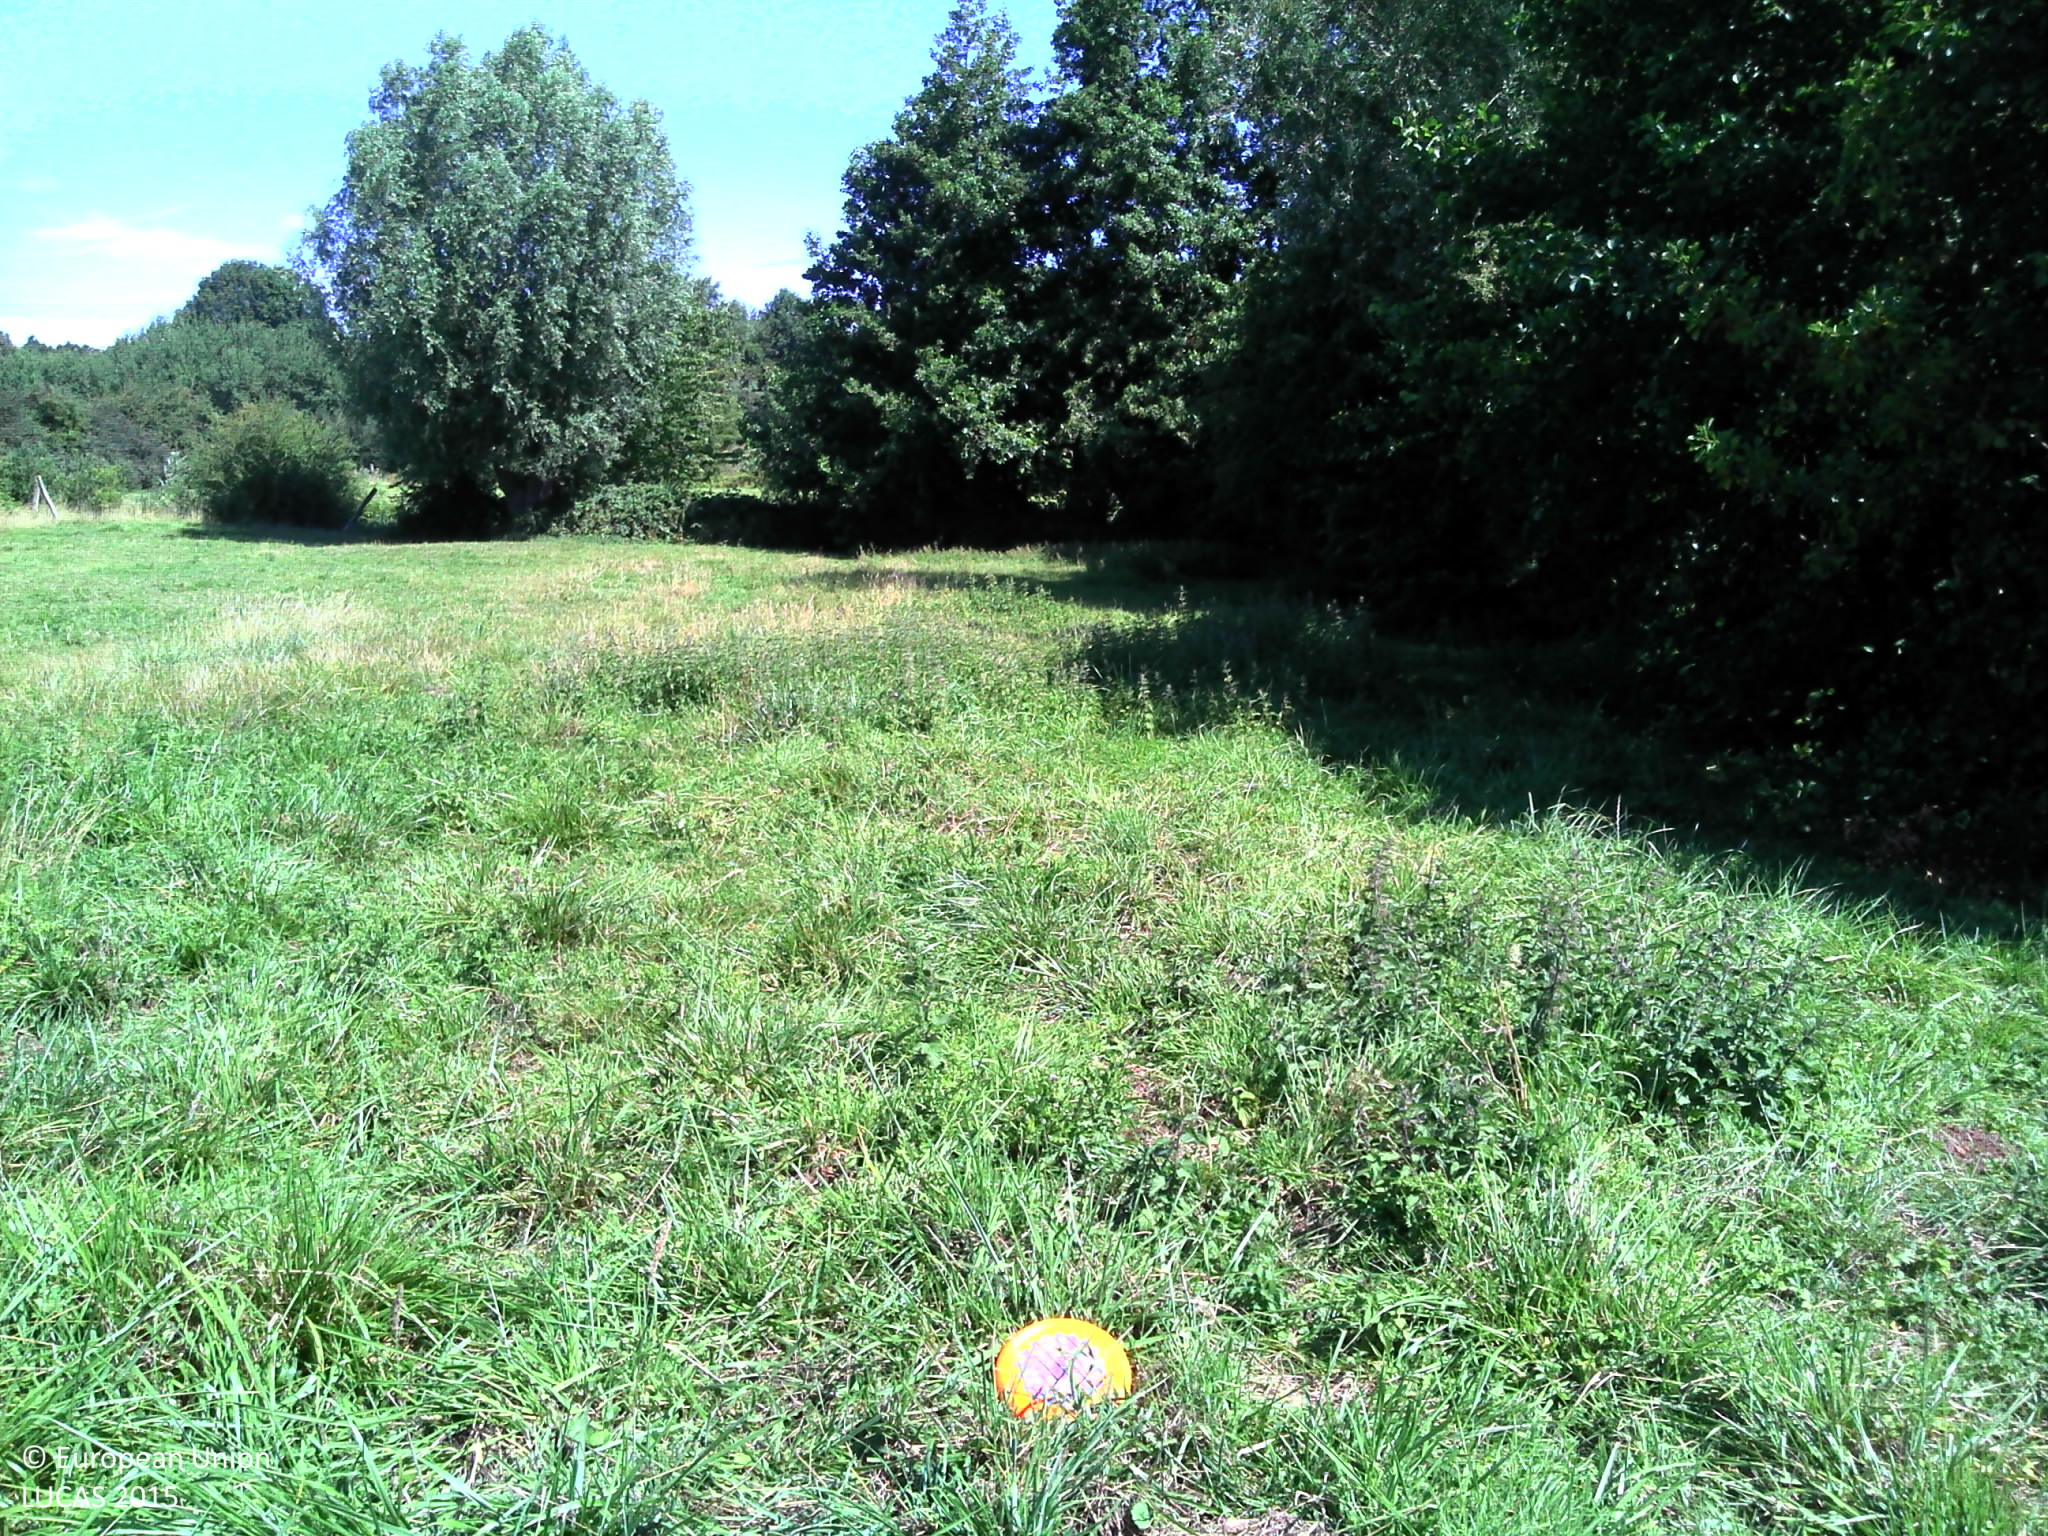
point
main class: Grassland
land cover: Grassland without tree/shrub cover
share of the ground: > 75 %
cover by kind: herbaceous plants 95 %, lichens and mosses 5 %
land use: Agriculture (excluding fallow land and kitchen gardens)
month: August
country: FR
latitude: 50.3586
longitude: 3.1736
